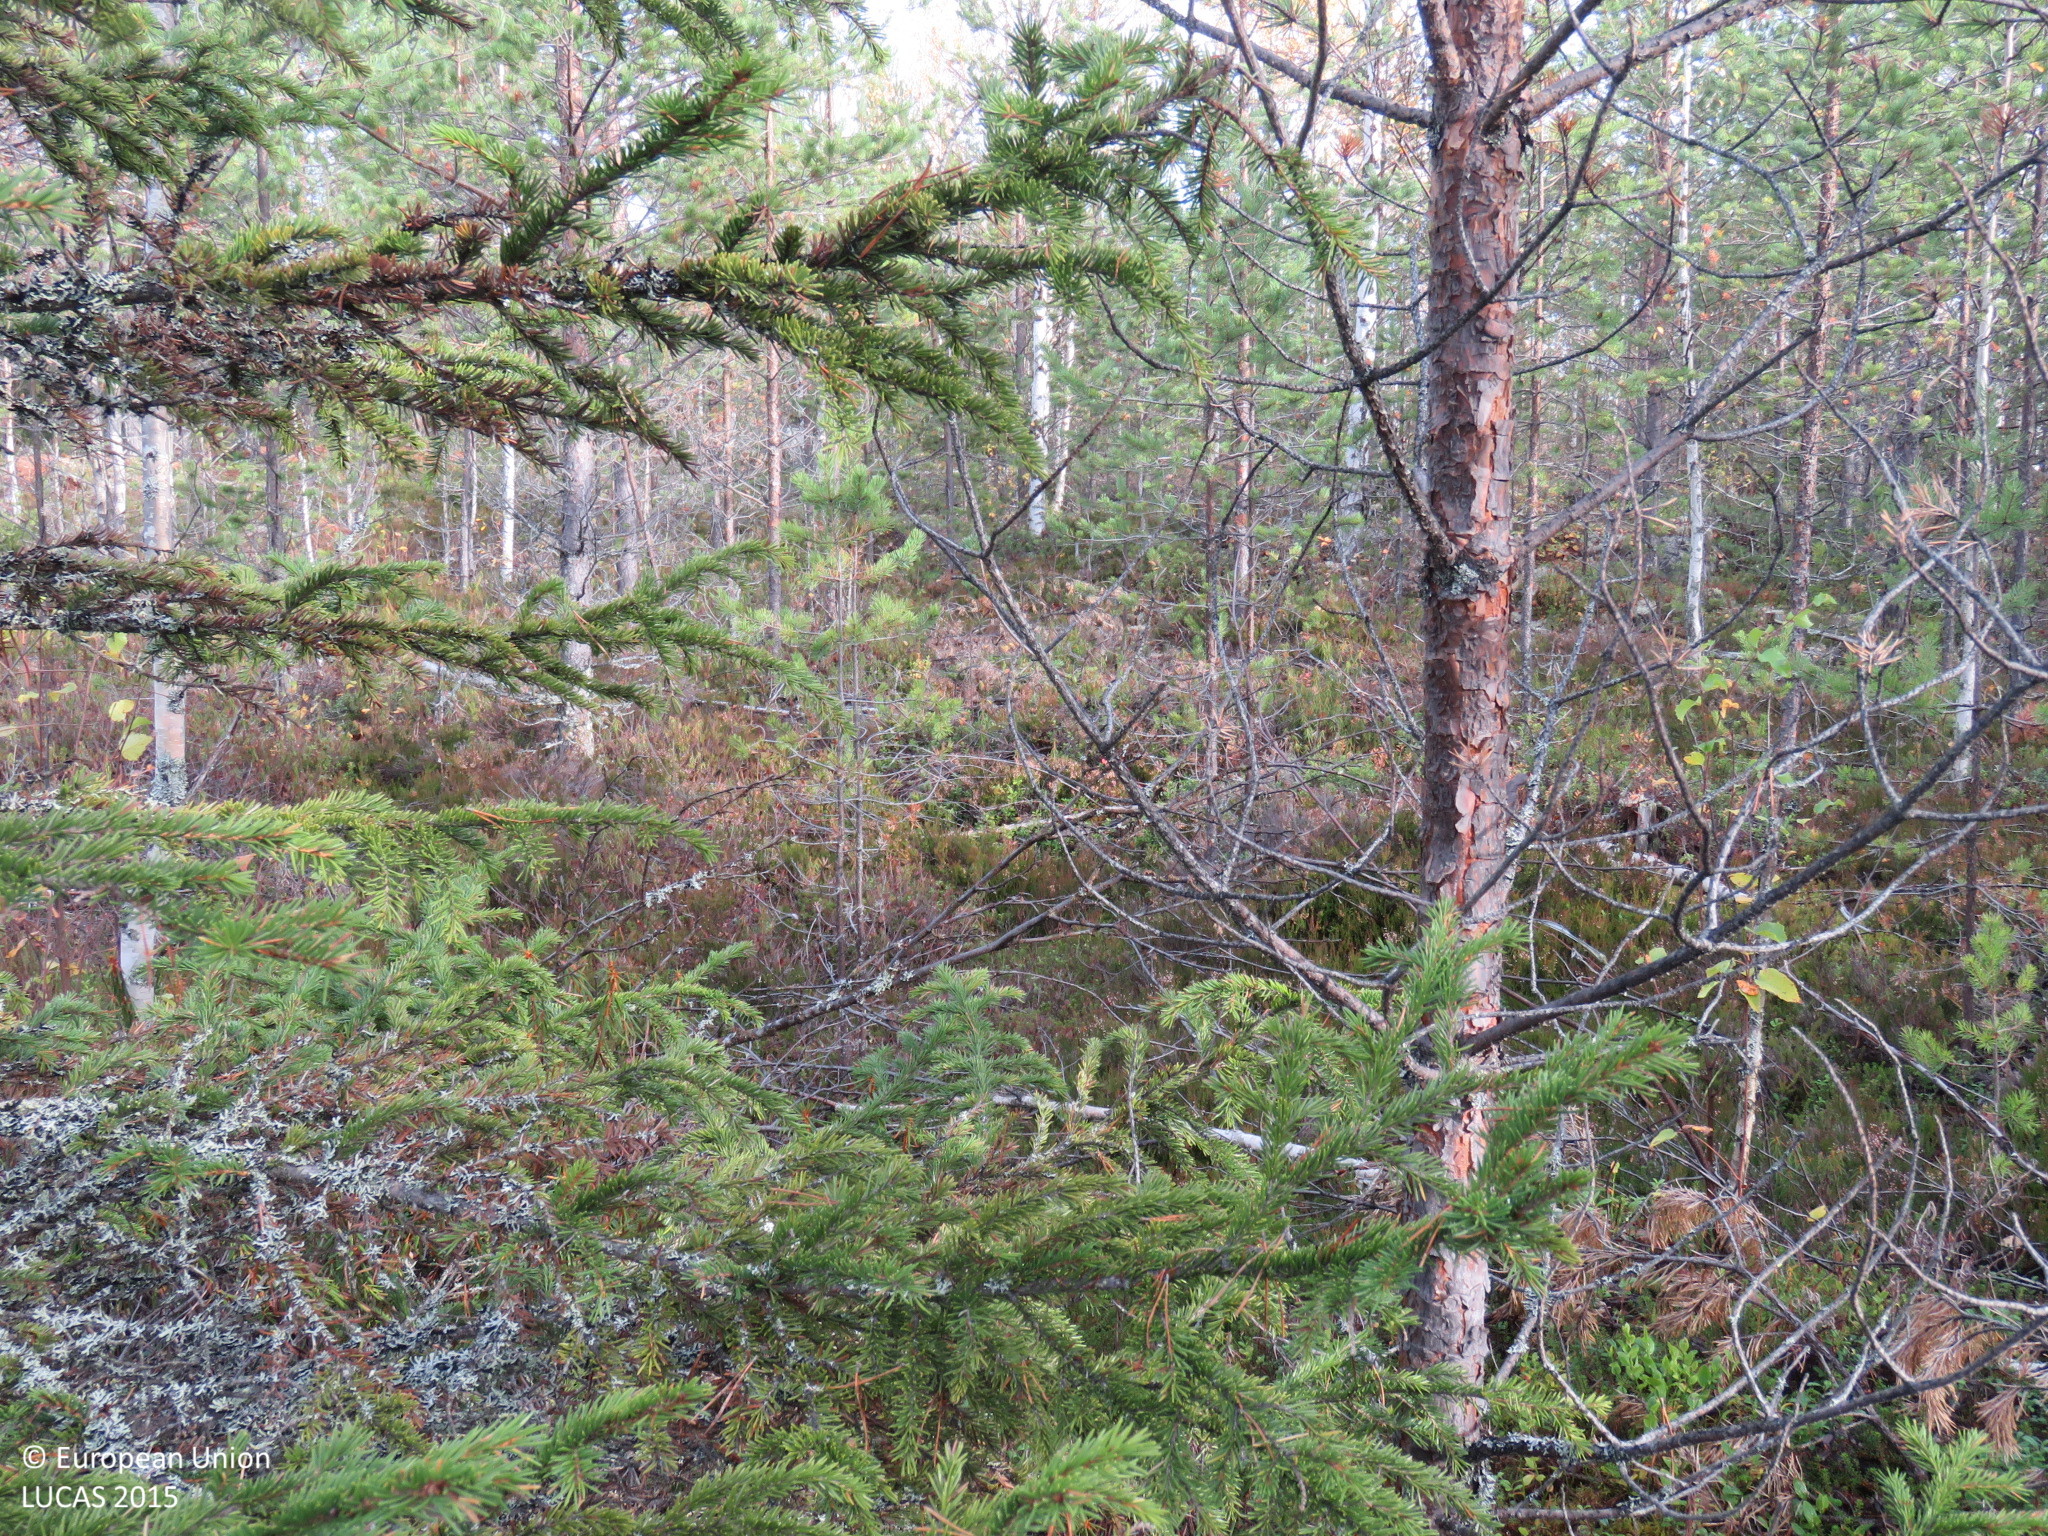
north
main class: Woodland
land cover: Other mixed woodland
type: boreal forest
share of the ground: > 75 %
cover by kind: coniferous forest trees 55 %, broadleaved forest trees 30 %, shrubs 10 %, lichens and mosses 5 %
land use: Forestry
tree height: > 5 m
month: September
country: FI
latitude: 64.9614
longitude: 27.1304
